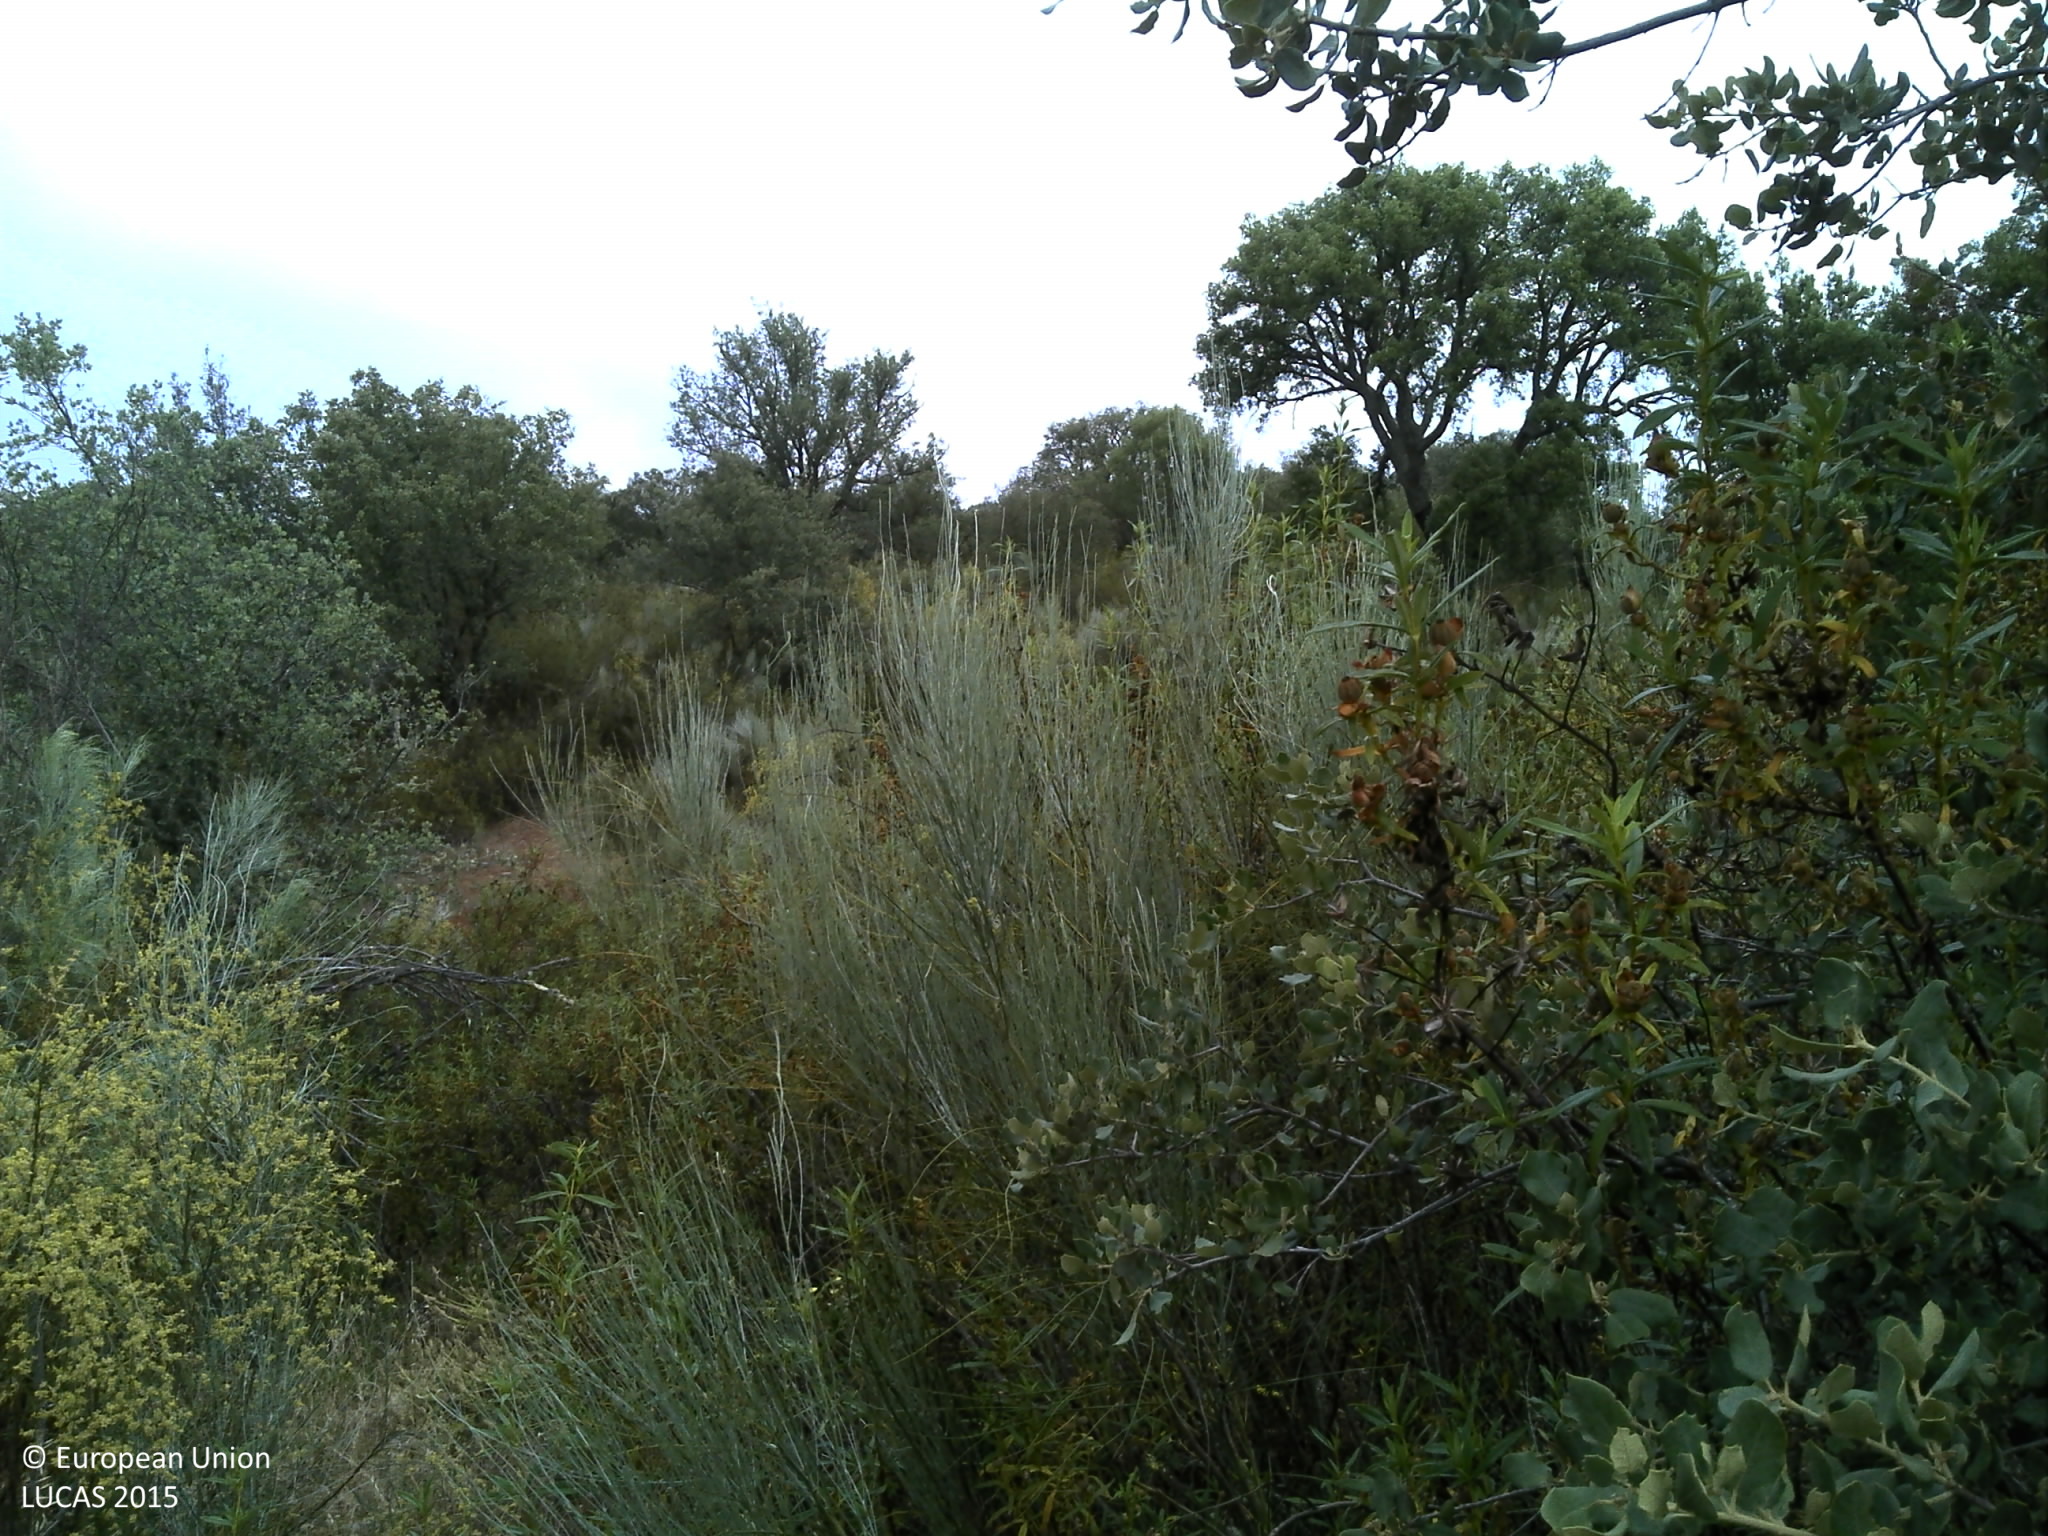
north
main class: Woodland
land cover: Broadleaved woodland
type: broadleaved evergreen forest
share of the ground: 10 - 25 %
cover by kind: shrubs 75 %, broadleaved forest trees 15 %, herbaceous plants 10 %
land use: Forestry
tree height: > 5 m
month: June
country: PT
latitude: 38.5799
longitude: -7.8421
